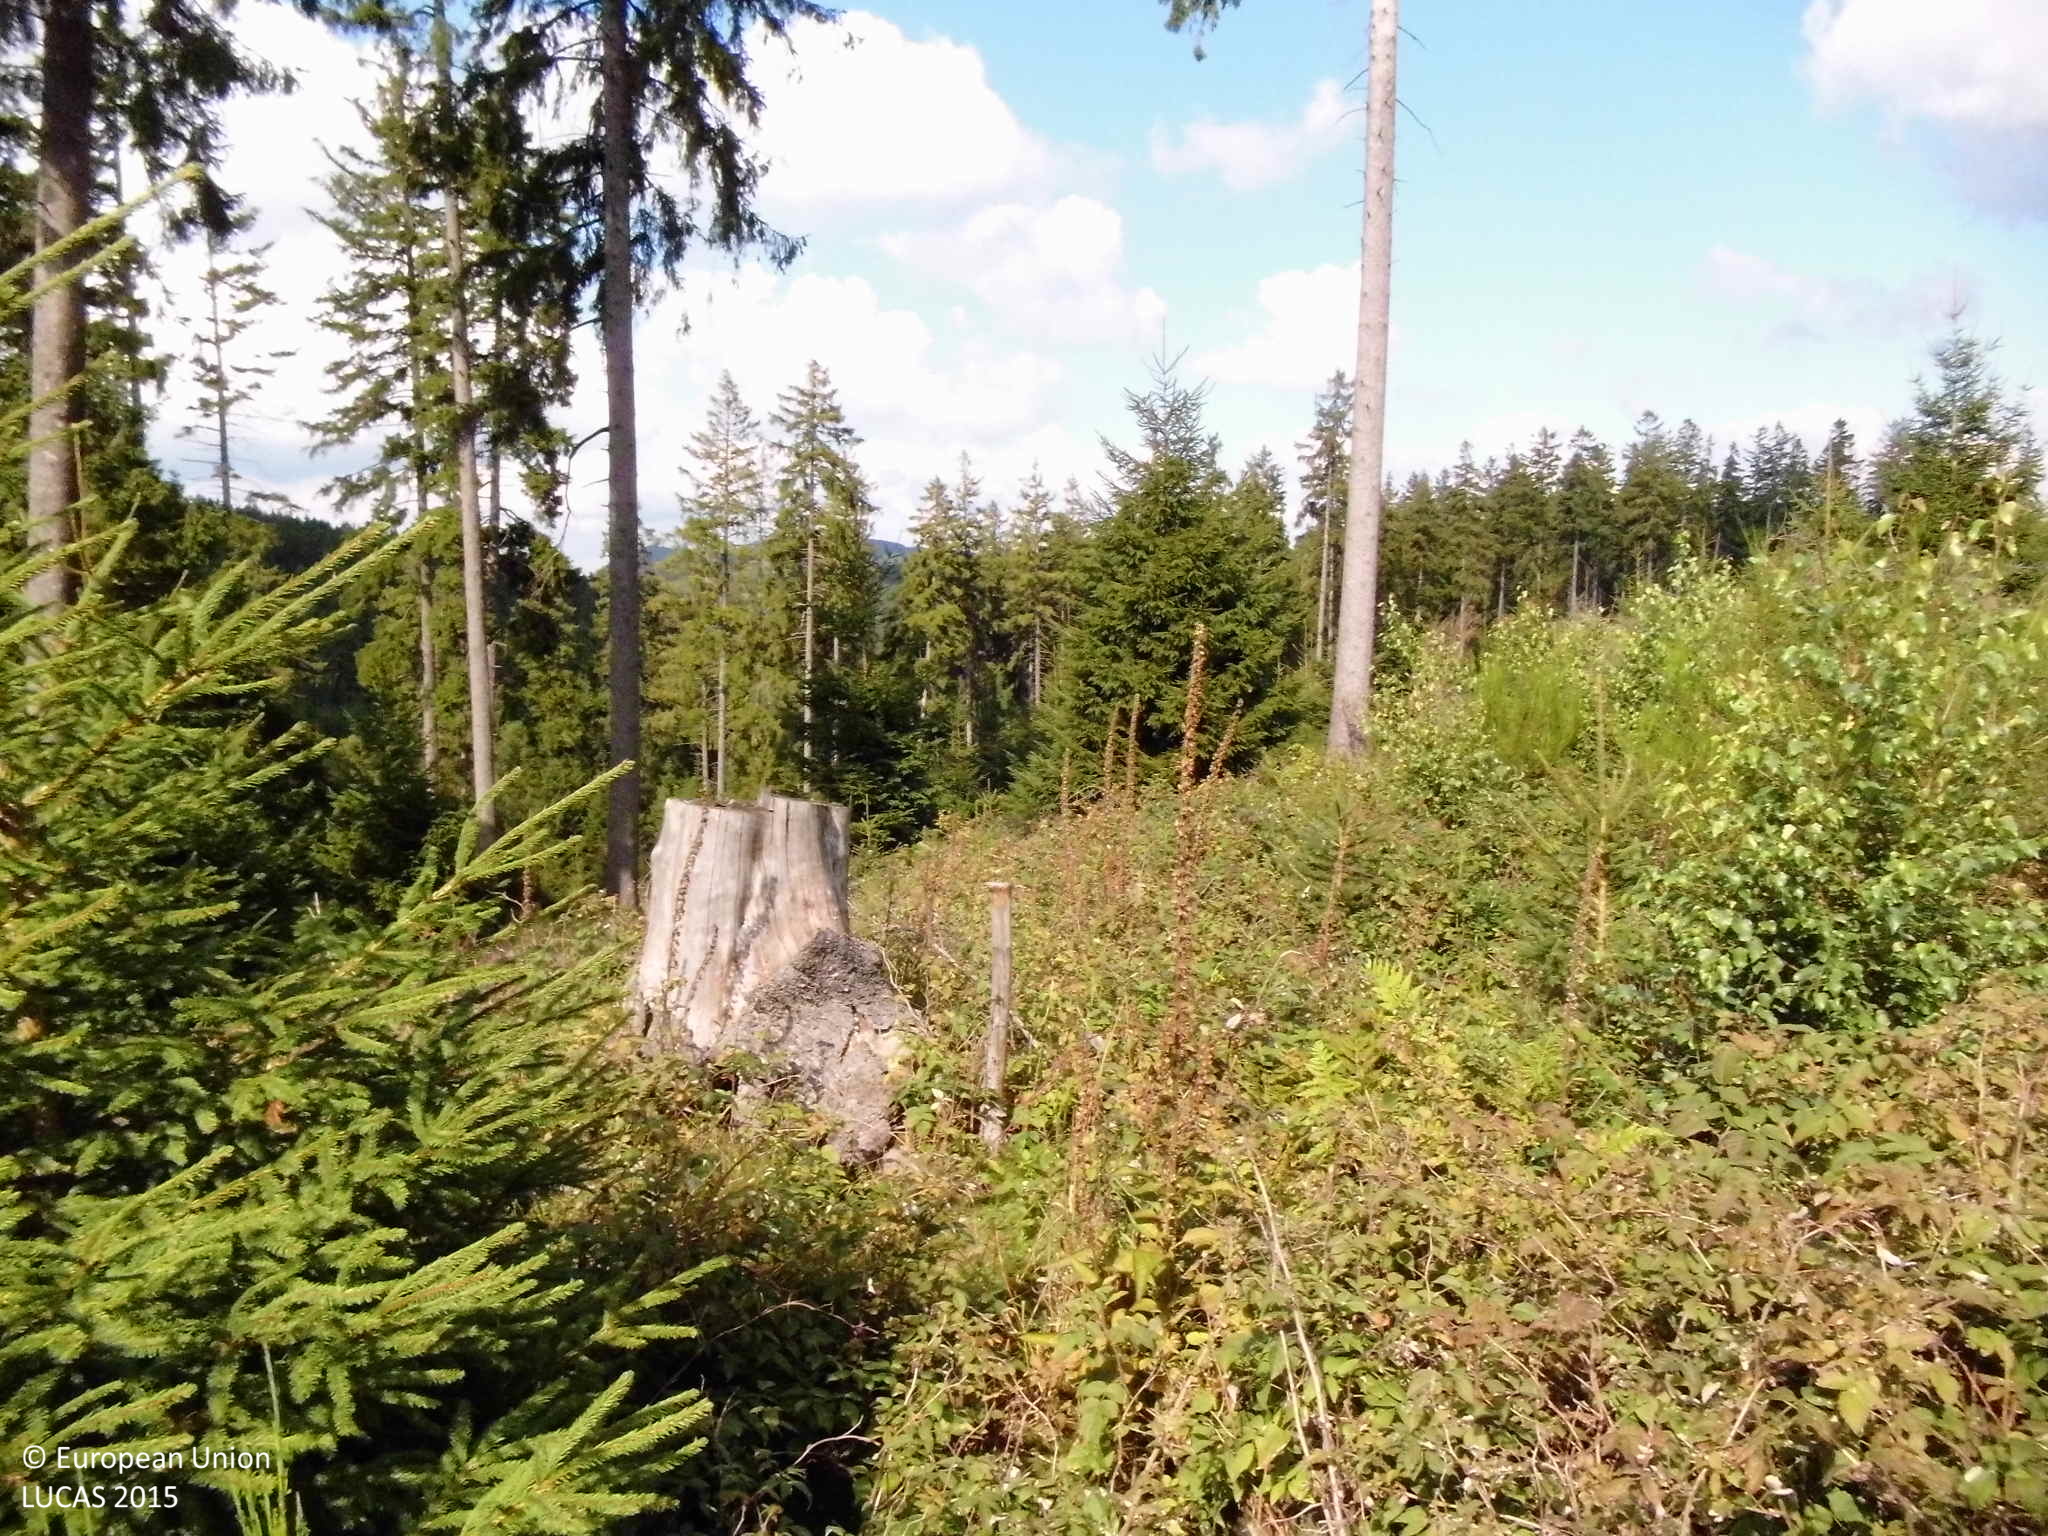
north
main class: Shrubland
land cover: Shrubland with sparse tree cover
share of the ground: > 75 %
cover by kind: shrubs 50 %, herbaceous plants 25 %, lichens and mosses 20 %, coniferous forest trees 5 %
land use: Forestry
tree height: < 5 m
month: September
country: DE
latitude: 51.2888
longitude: 8.4661
